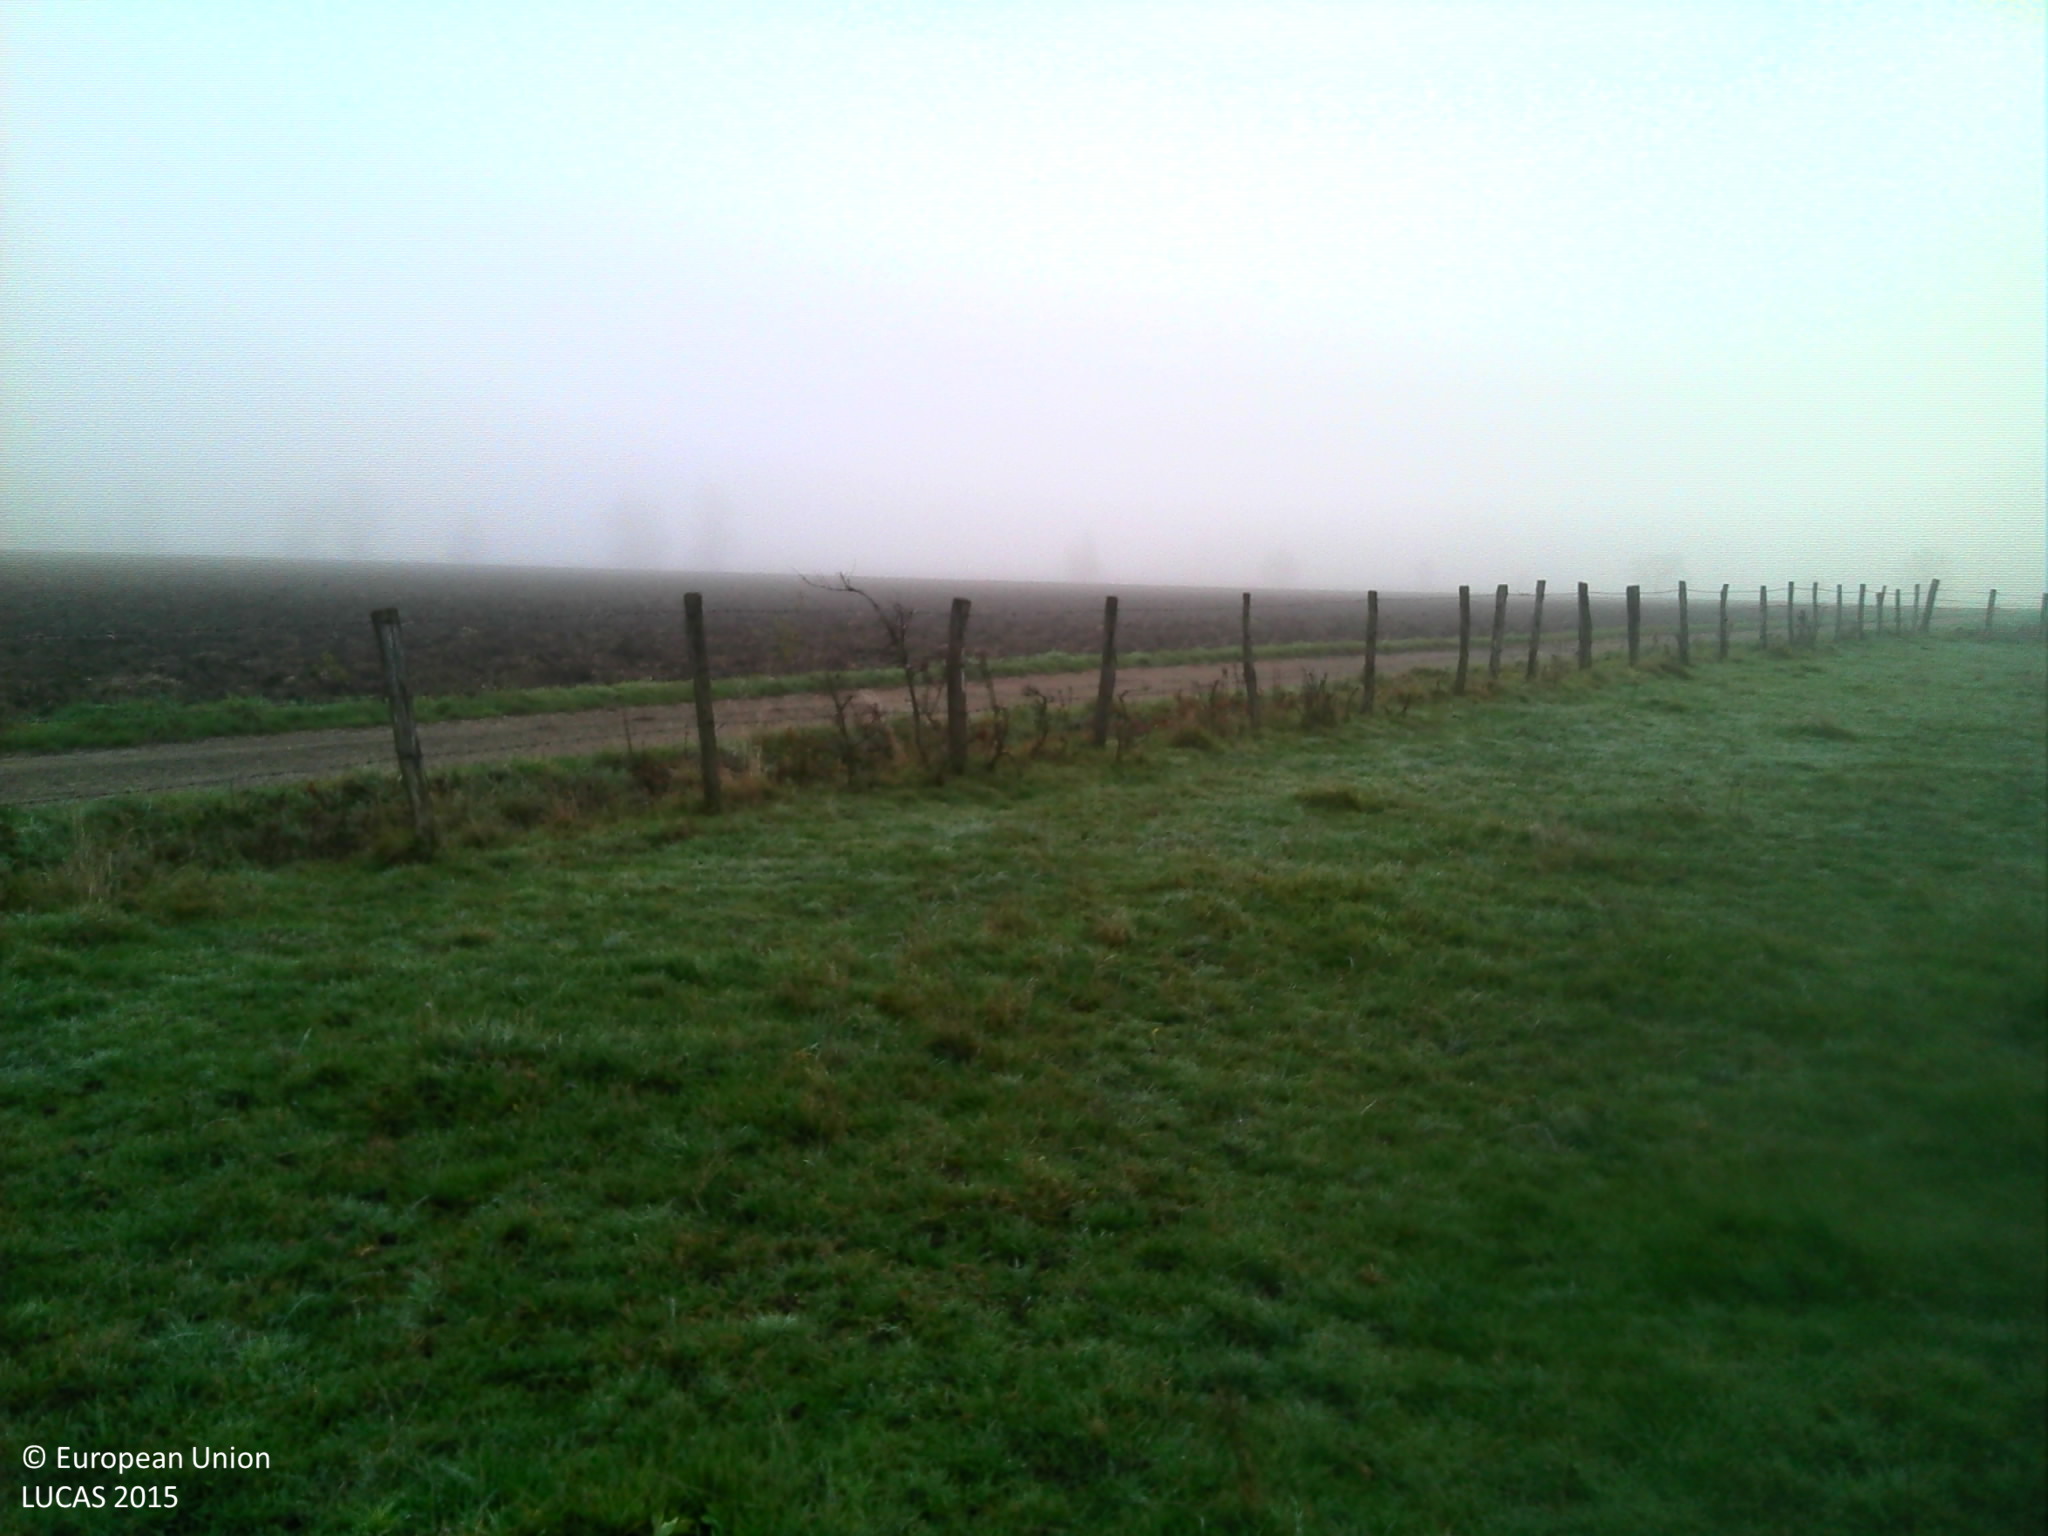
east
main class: Grassland
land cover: Grassland without tree/shrub cover
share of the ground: > 75 %
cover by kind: herbaceous plants 100 %
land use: Agriculture (excluding fallow land and kitchen gardens)
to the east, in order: Grassland without tree/shrub cover; Fences; Grass margins; Paved roads, cycling and walking lanes; Grass margins; Maize
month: December
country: FR
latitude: 46.9605
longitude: 5.0995
